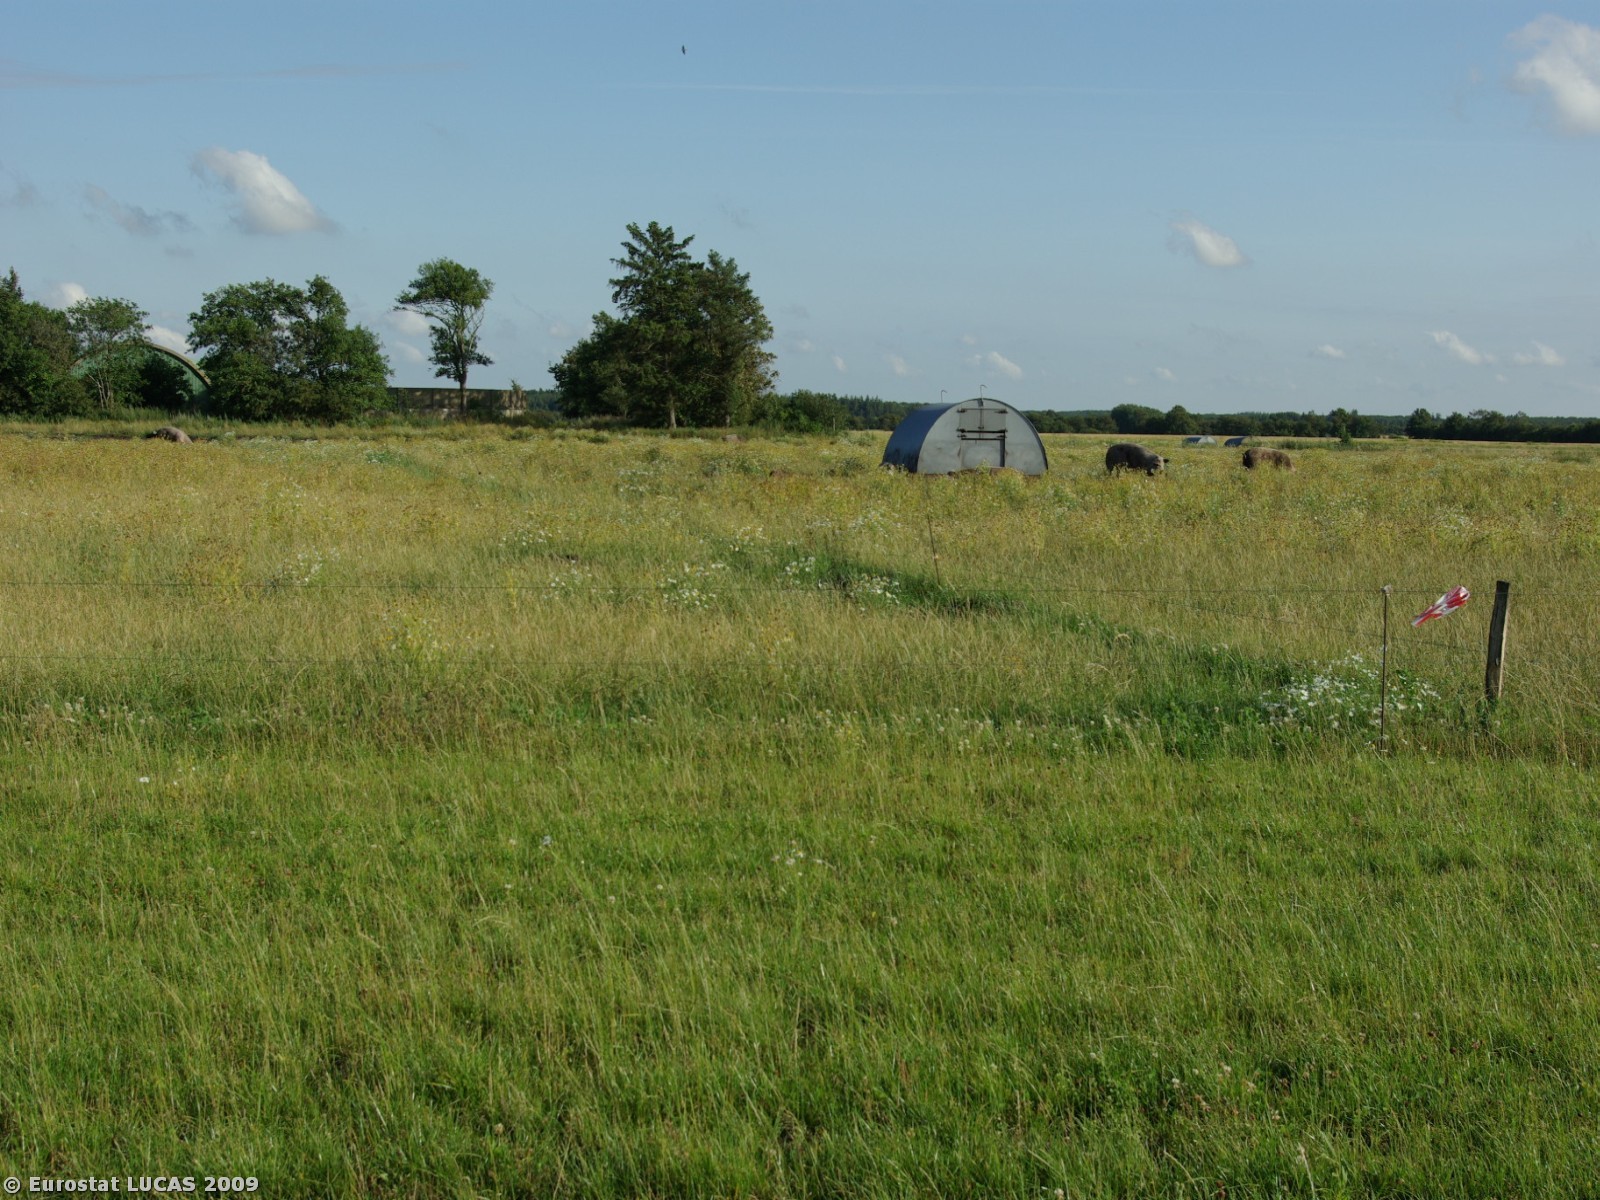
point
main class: Grassland
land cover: Grassland without tree/shrub cover
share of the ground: > 75 %
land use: Agriculture (excluding fallow land and kitchen gardens)
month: July
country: DK
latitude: 55.1763
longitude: 8.8861
